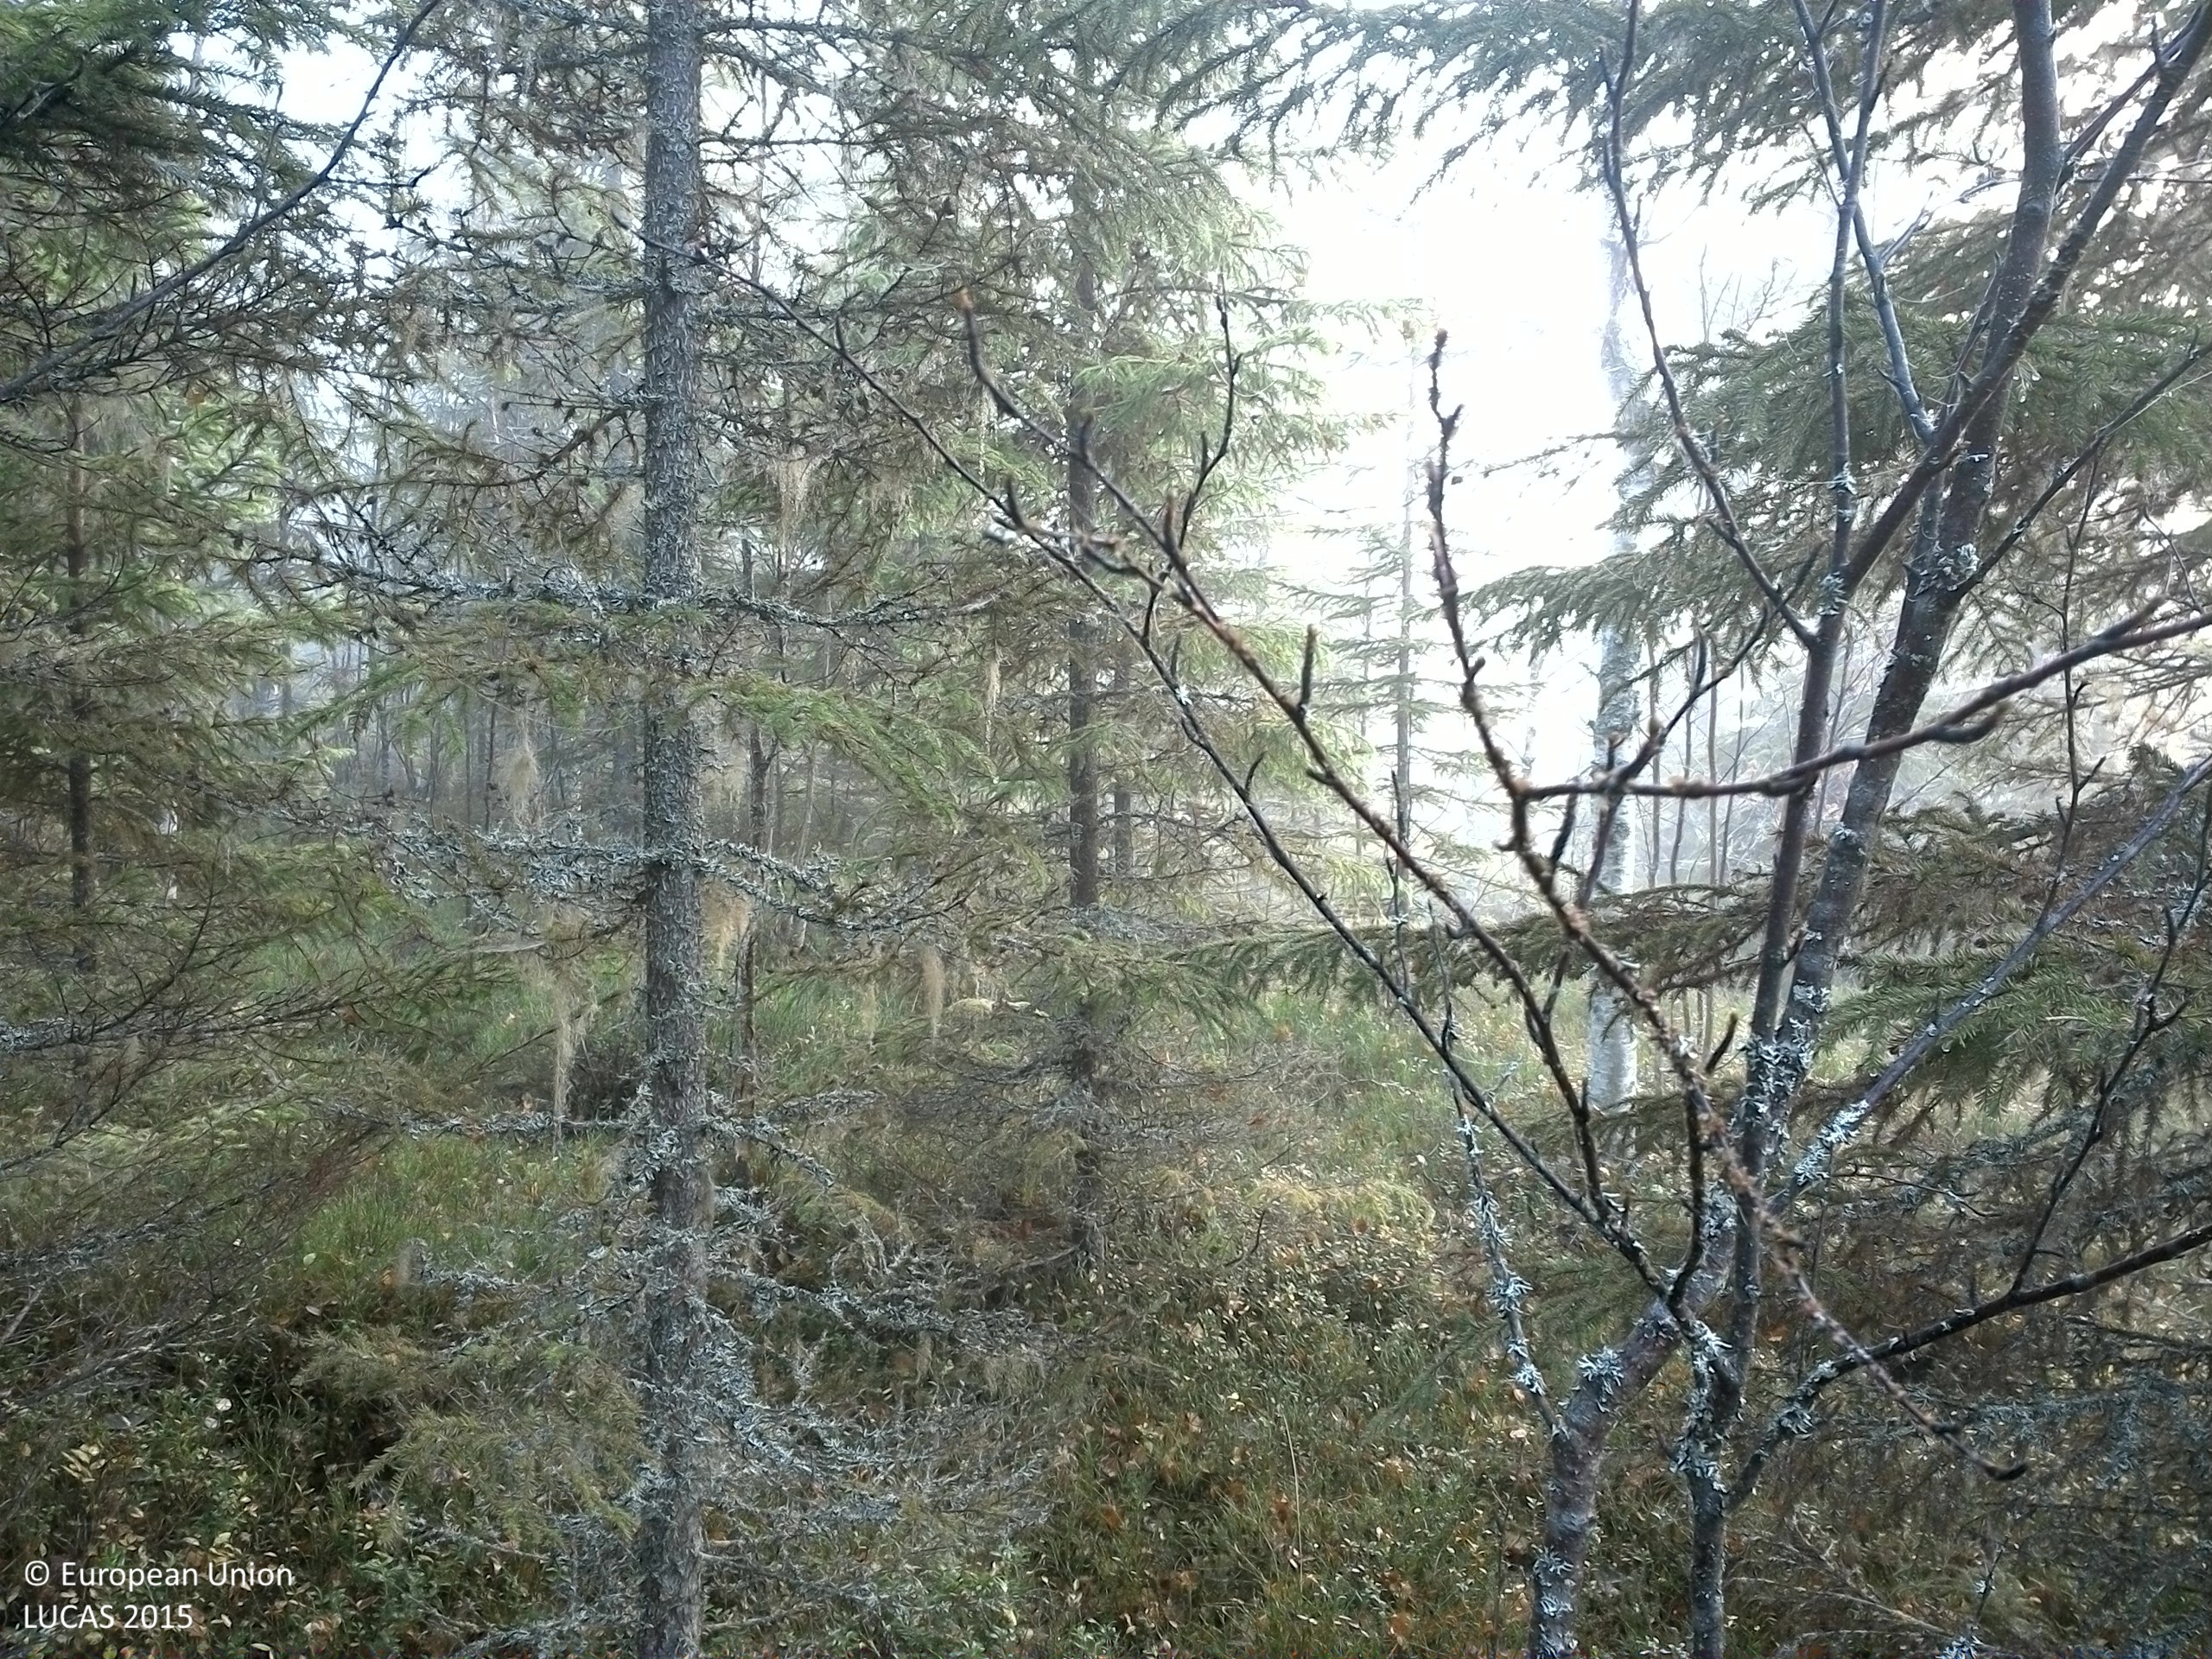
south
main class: Woodland
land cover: Spruce dominated coniferous woodland
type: boreal forest
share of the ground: 50 - 75 %
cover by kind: coniferous forest trees 50 %, shrubs 25 %, broadleaved forest trees 15 %, lichens and mosses 10 %
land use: Forestry
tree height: > 5 m
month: October
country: SE
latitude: 64.0556
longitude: 16.3011
